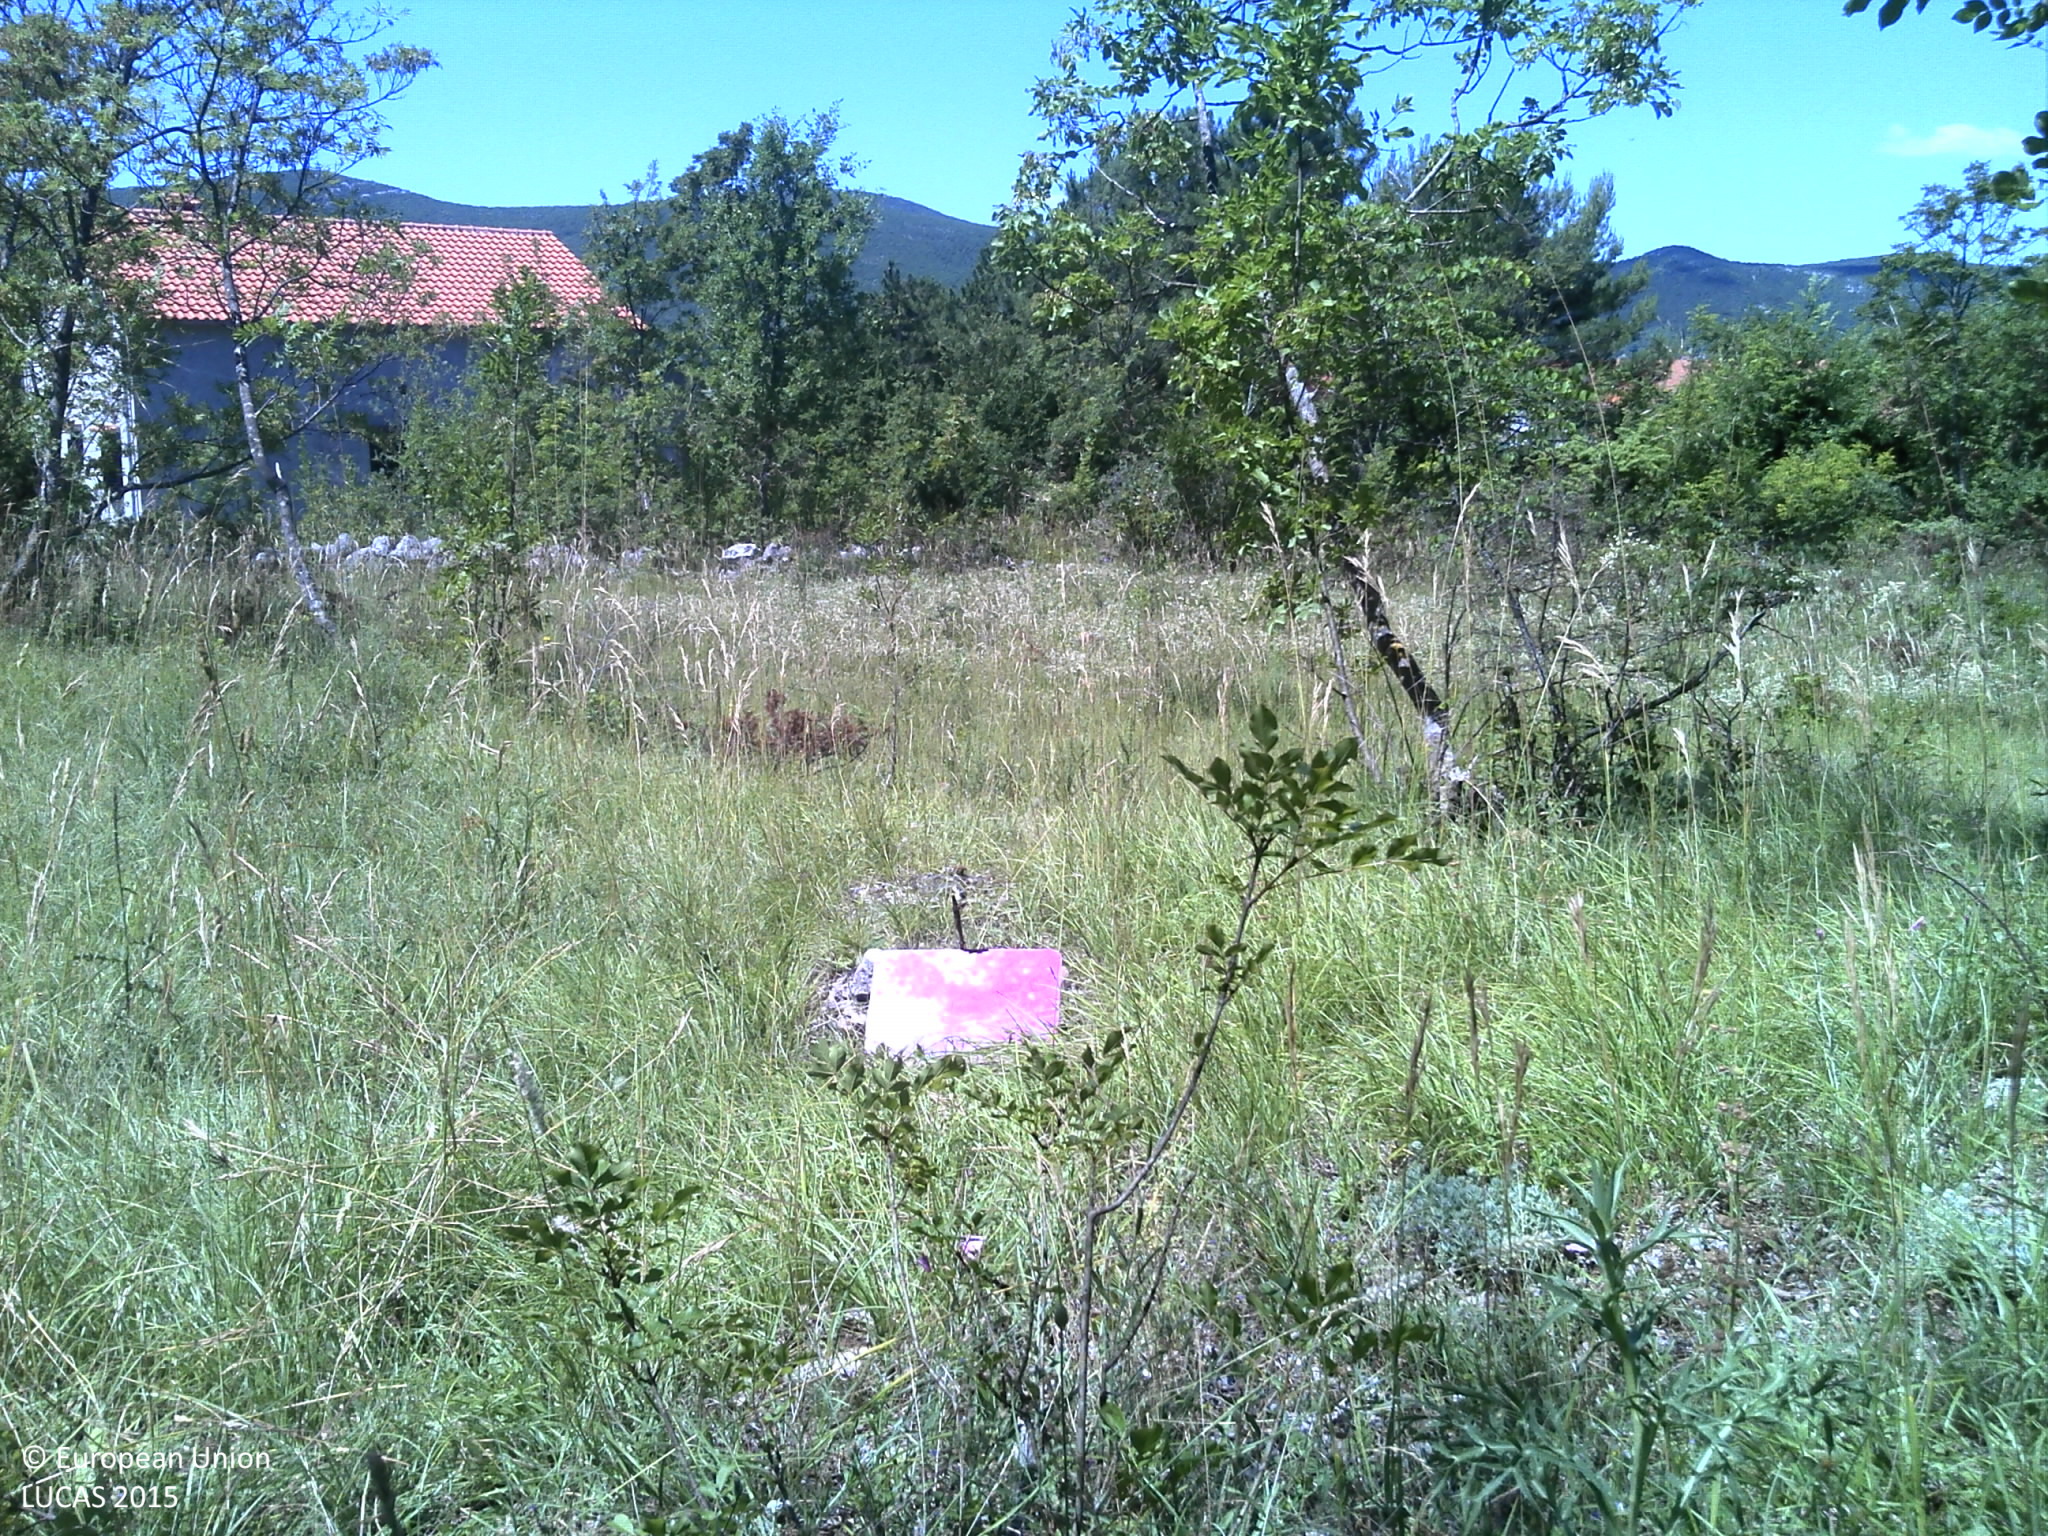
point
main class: Grassland
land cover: Grassland with sparse tree/shrub cover
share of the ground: > 75 %
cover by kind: herbaceous plants 80 %, shrubs 10 %, broadleaved forest trees 5 %, unconsolidated bare surface 5 %
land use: Agriculture (excluding fallow land and kitchen gardens)
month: June
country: HR
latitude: 43.6338
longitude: 16.5980
